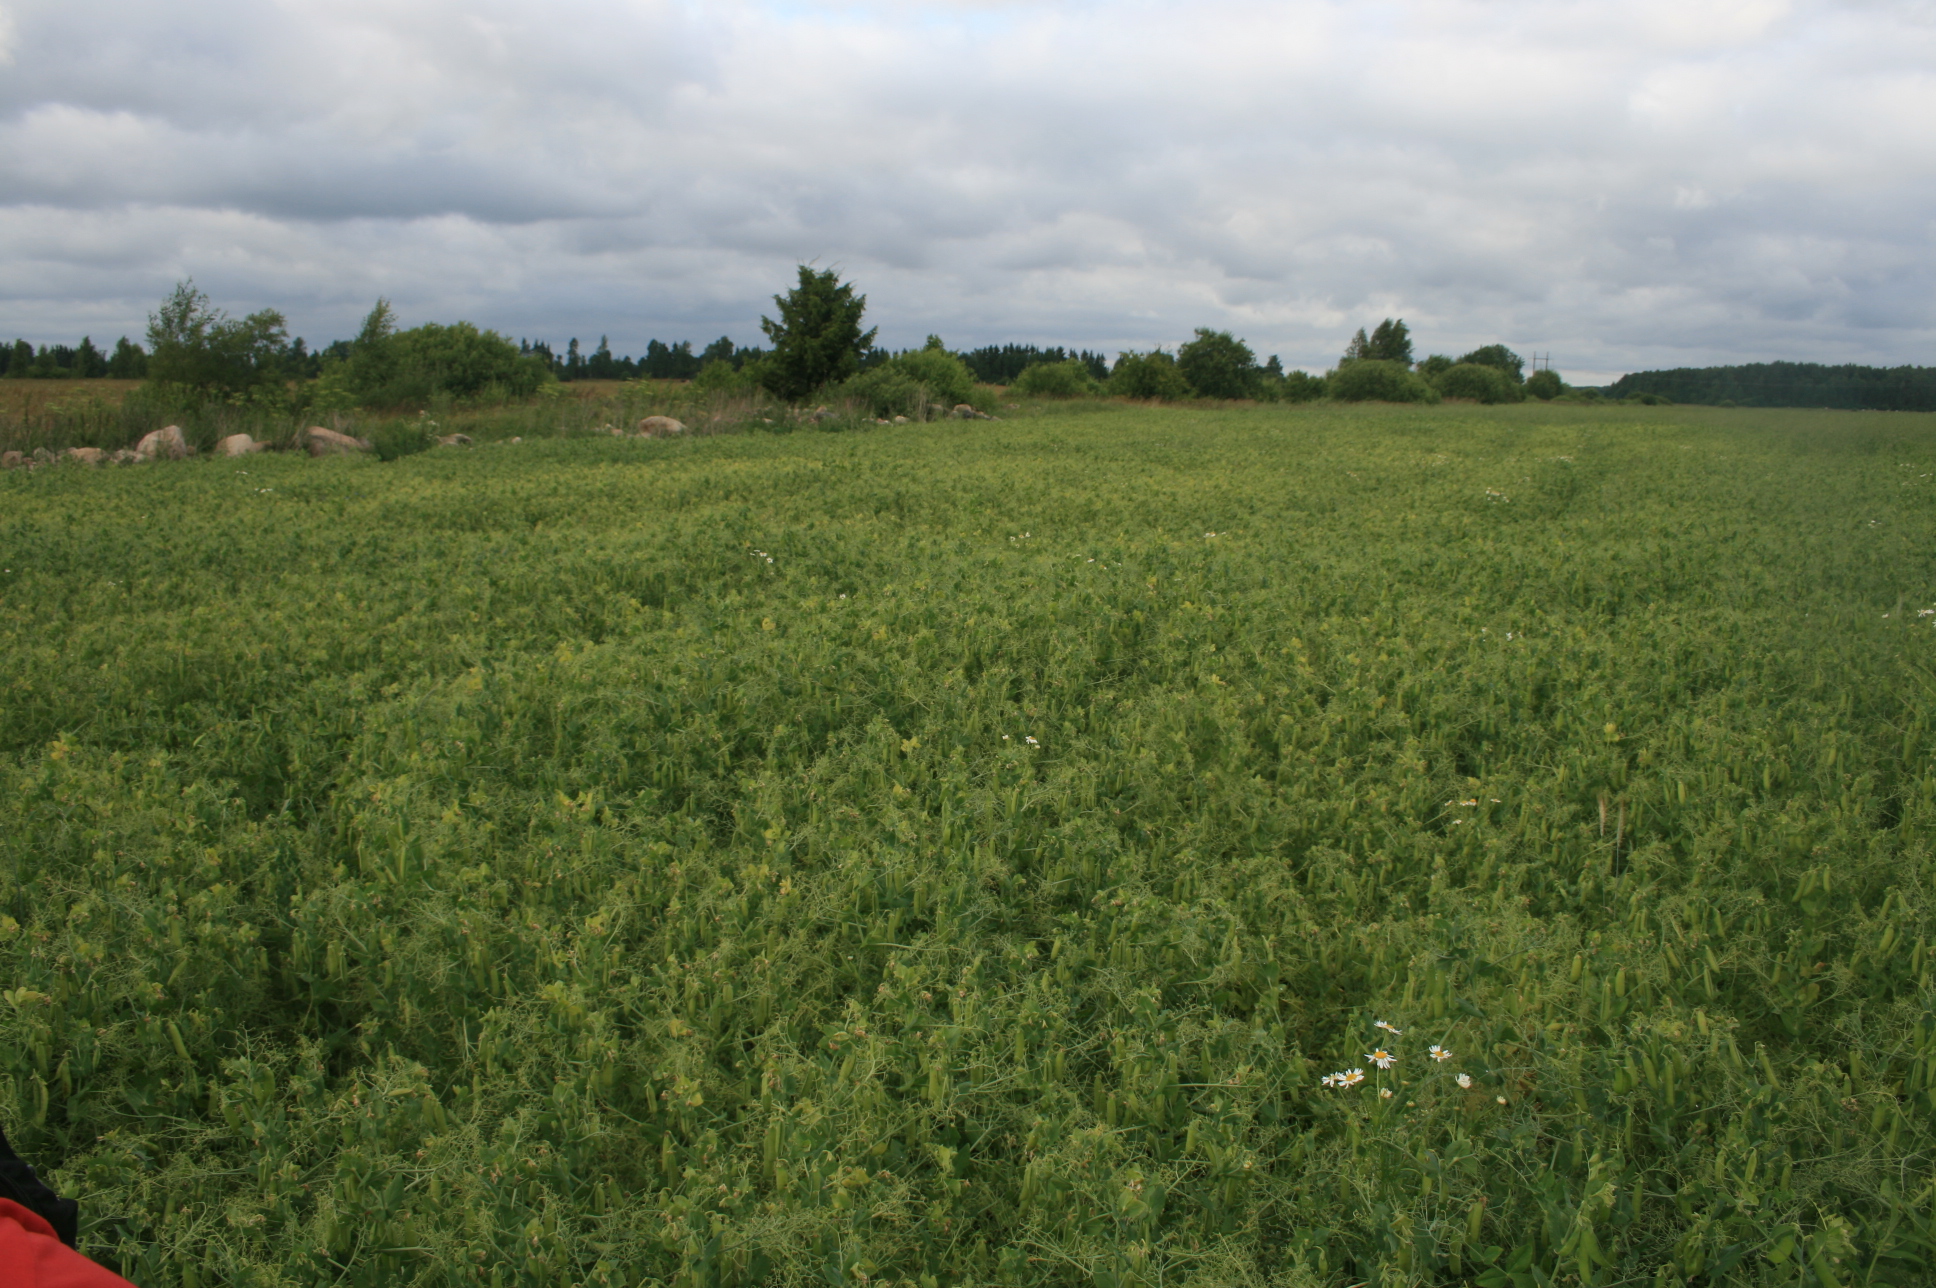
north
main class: Cropland
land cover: Dry pulses
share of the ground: > 75 %
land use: Agriculture (excluding fallow land and kitchen gardens)
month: July
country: LT
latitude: 55.9416
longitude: 21.2970
